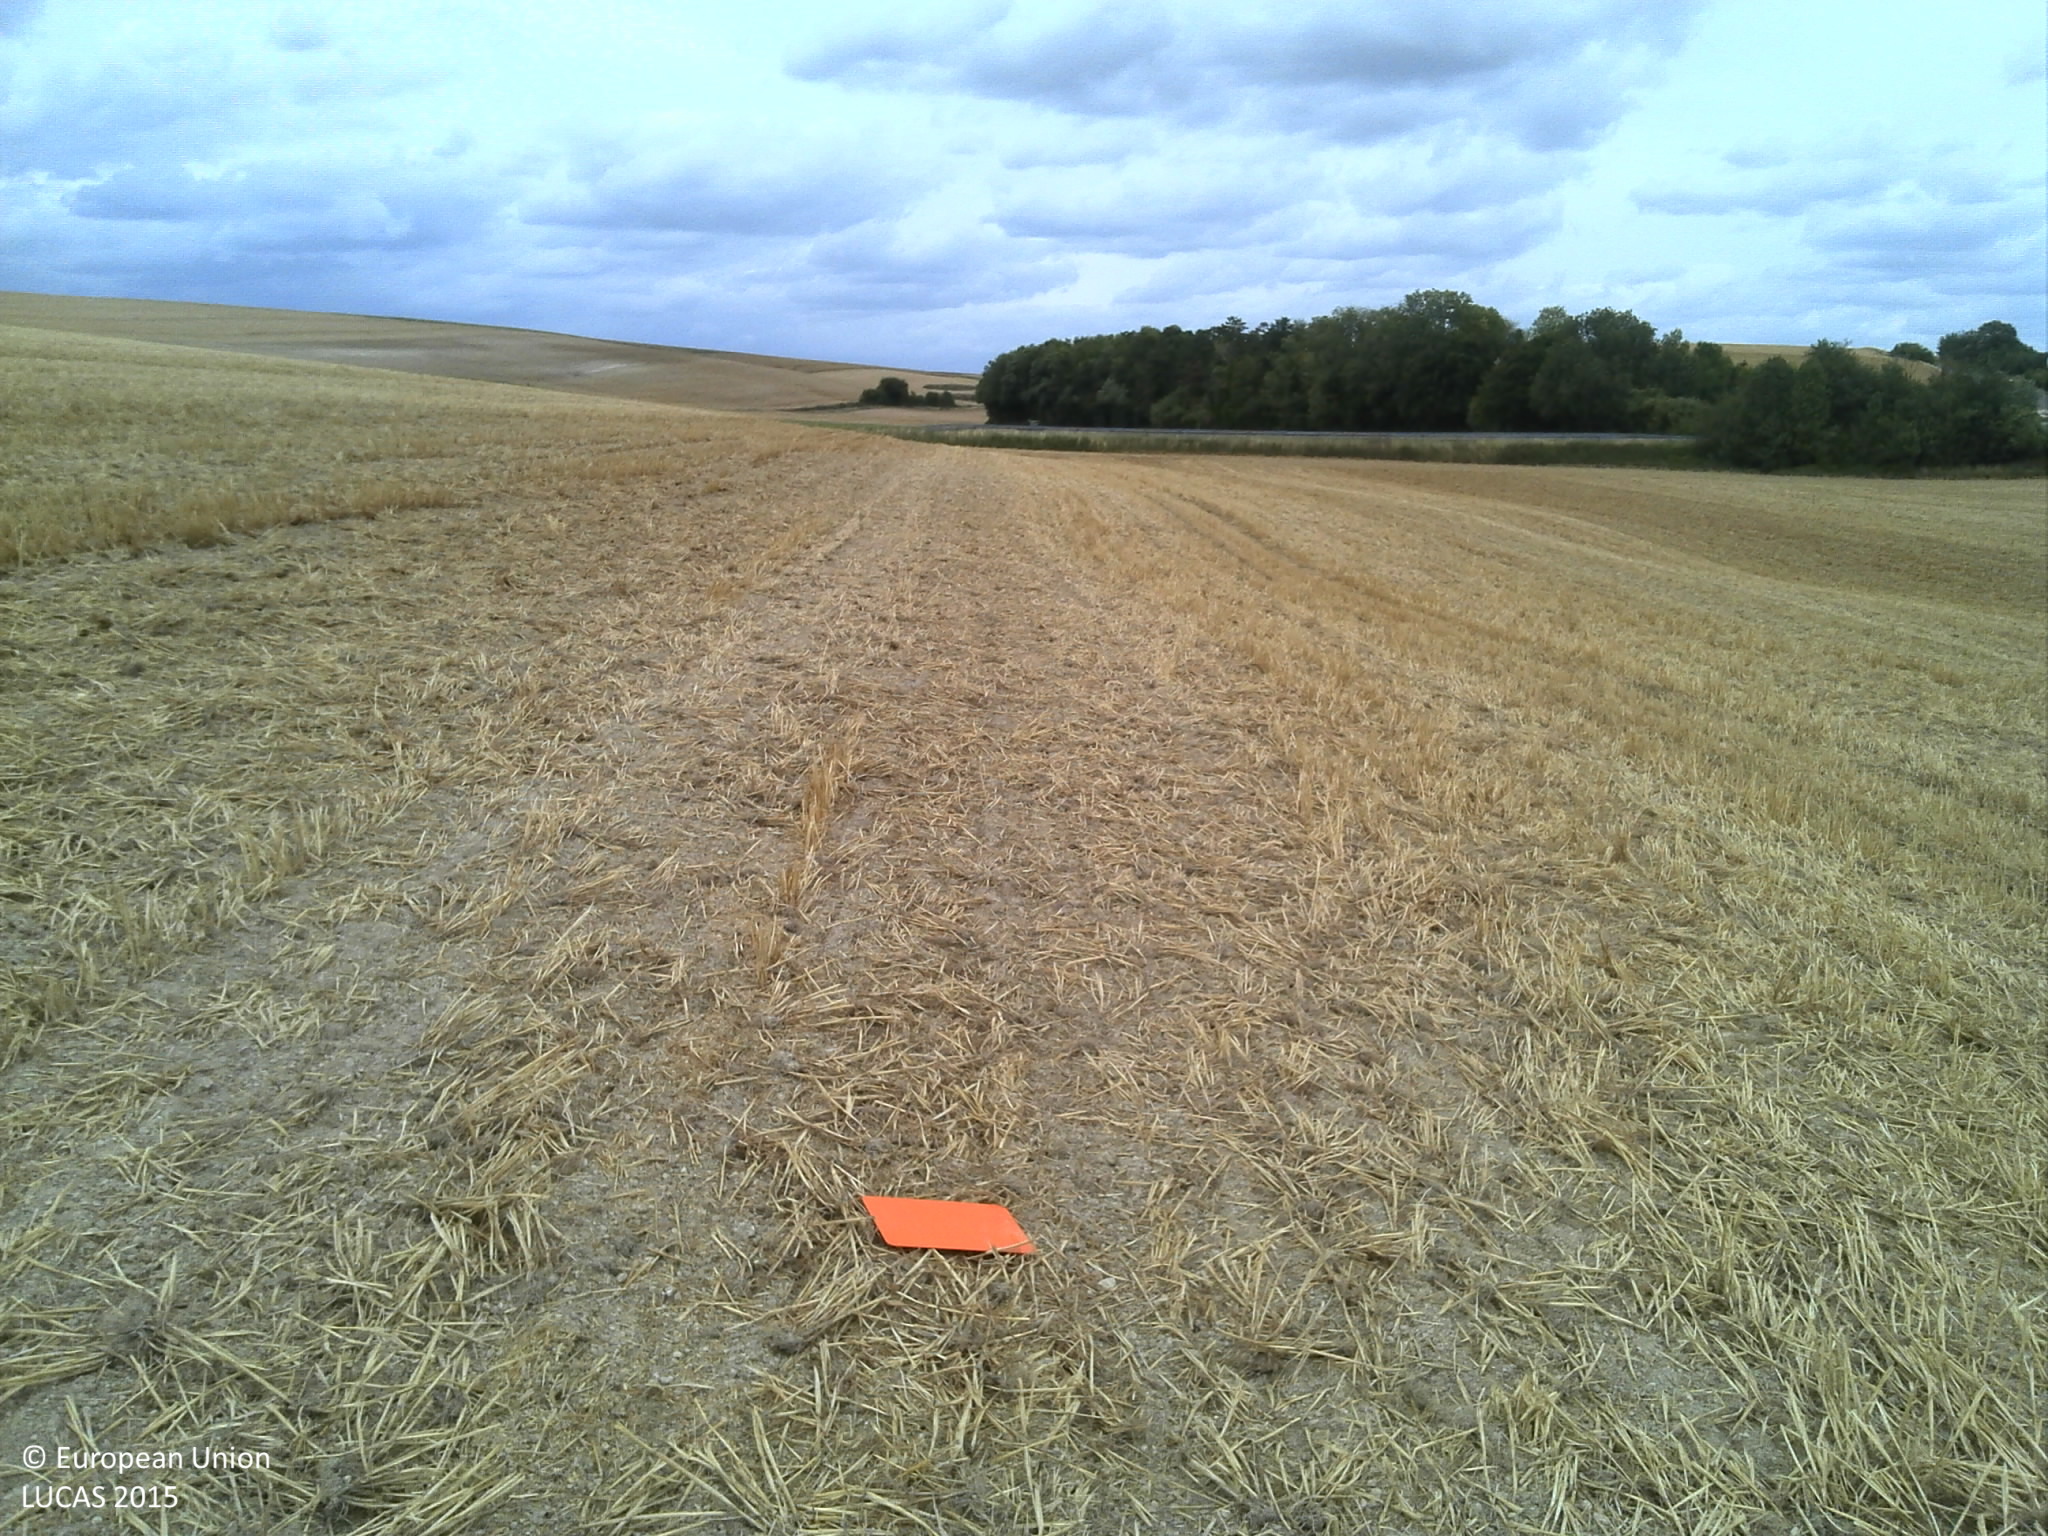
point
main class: Cropland
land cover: Common wheat
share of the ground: 25 - 50 %
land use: Agriculture (excluding fallow land and kitchen gardens)
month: July
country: FR
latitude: 49.5980
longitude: 4.0871
